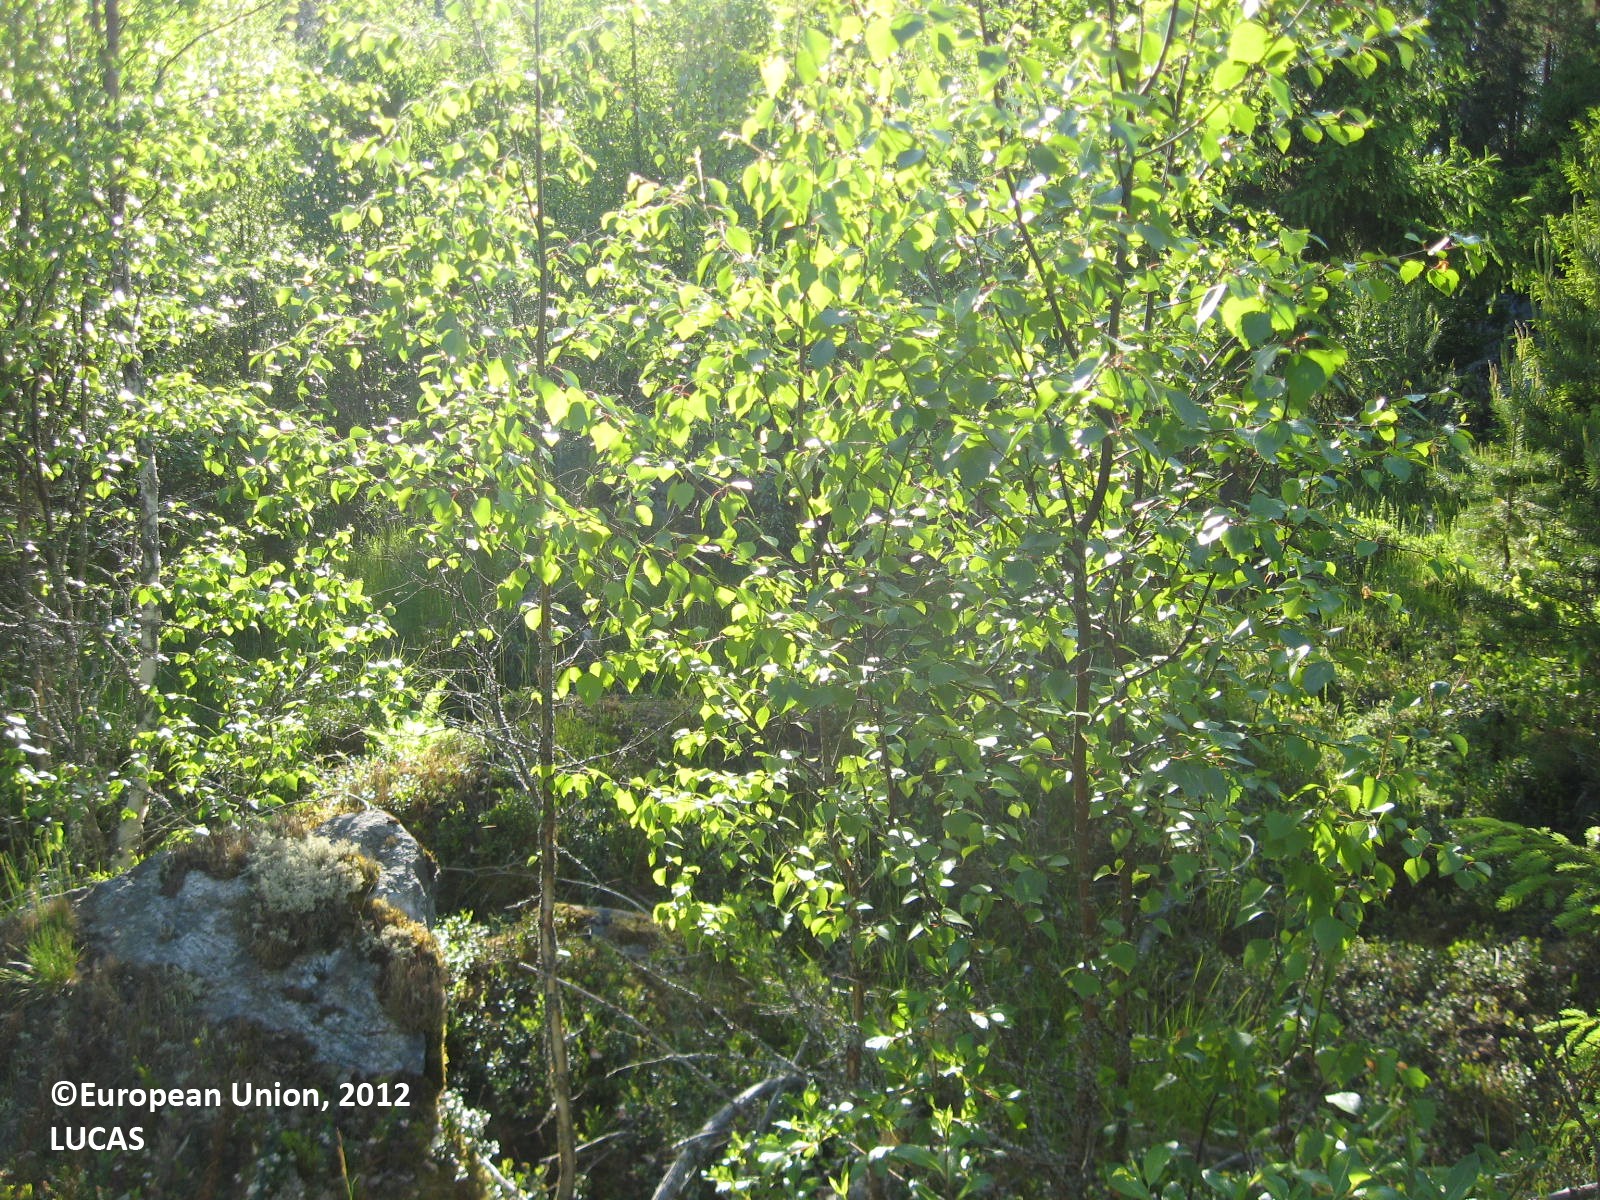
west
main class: Woodland
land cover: Broadleaved woodland
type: boreal forest
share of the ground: > 75 %
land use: Forestry
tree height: > 5 m
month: June
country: FI
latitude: 62.9438
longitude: 21.8875
